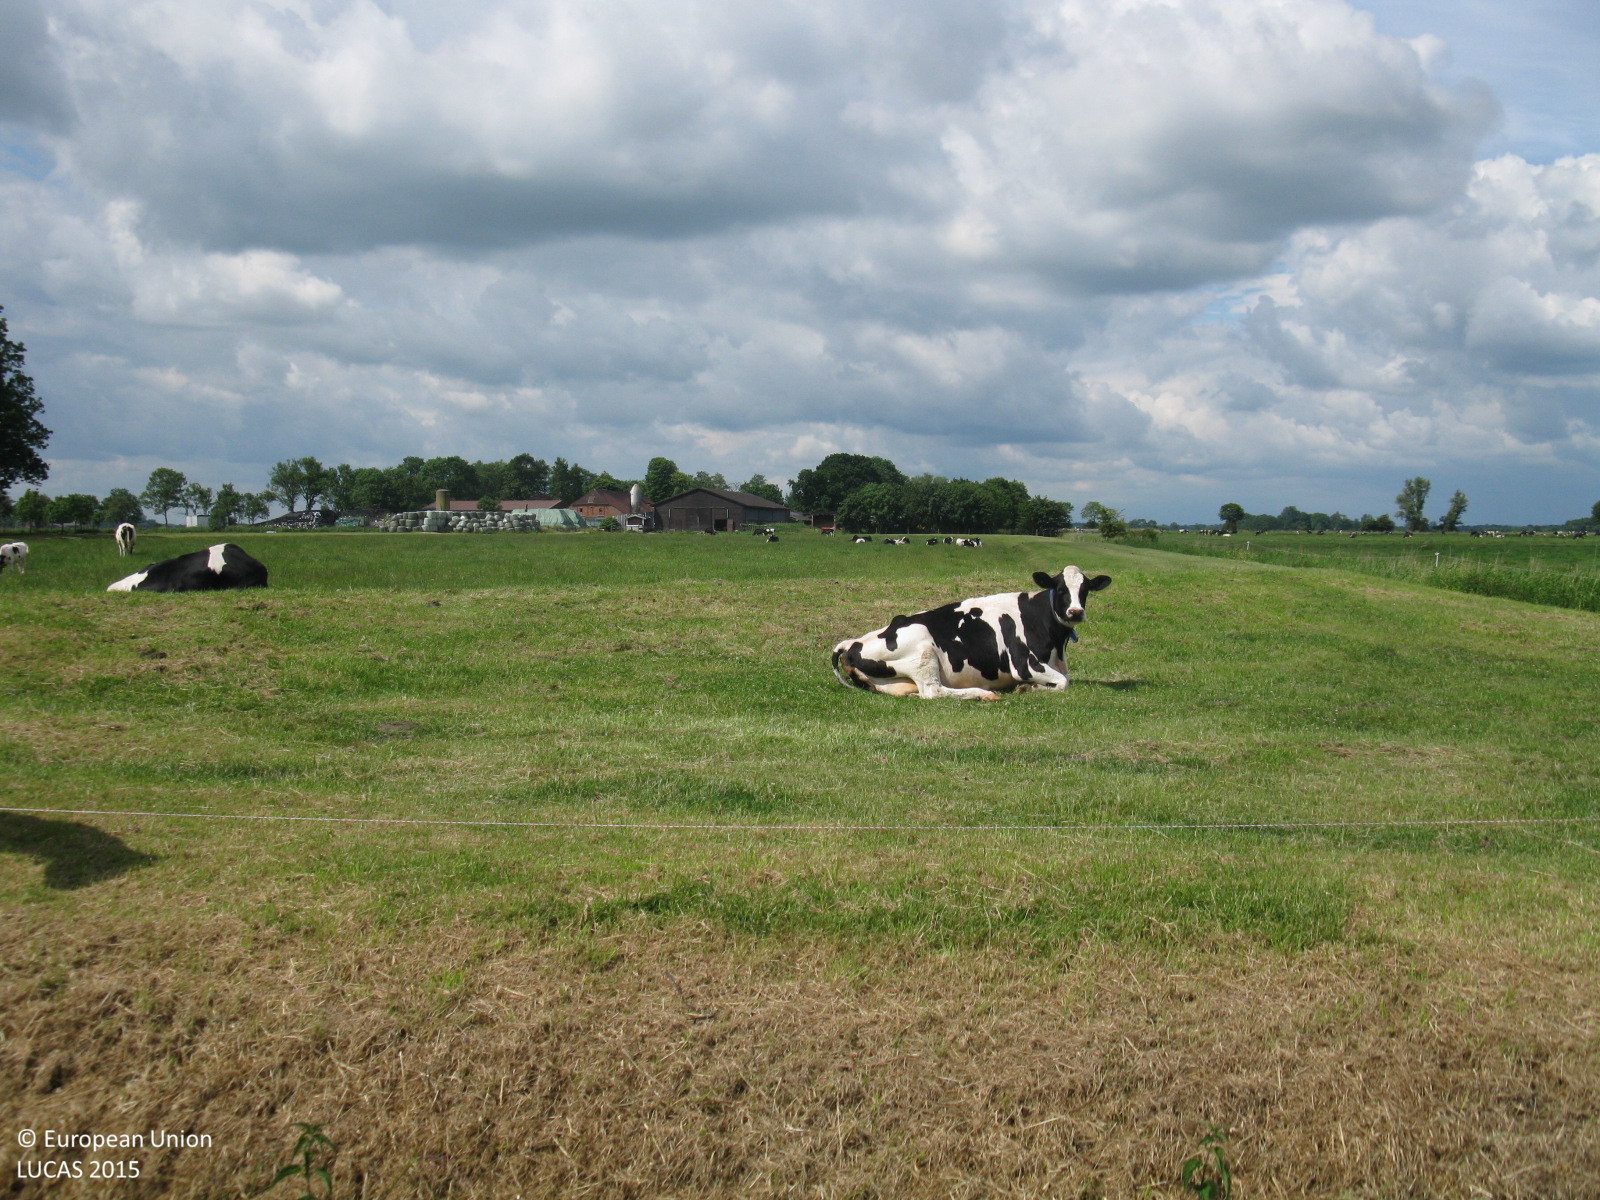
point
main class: Grassland
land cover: Grassland without tree/shrub cover
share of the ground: > 75 %
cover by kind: herbaceous plants 100 %
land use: Agriculture (excluding fallow land and kitchen gardens)
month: June
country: DE
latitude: 53.5107
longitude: 7.9650
